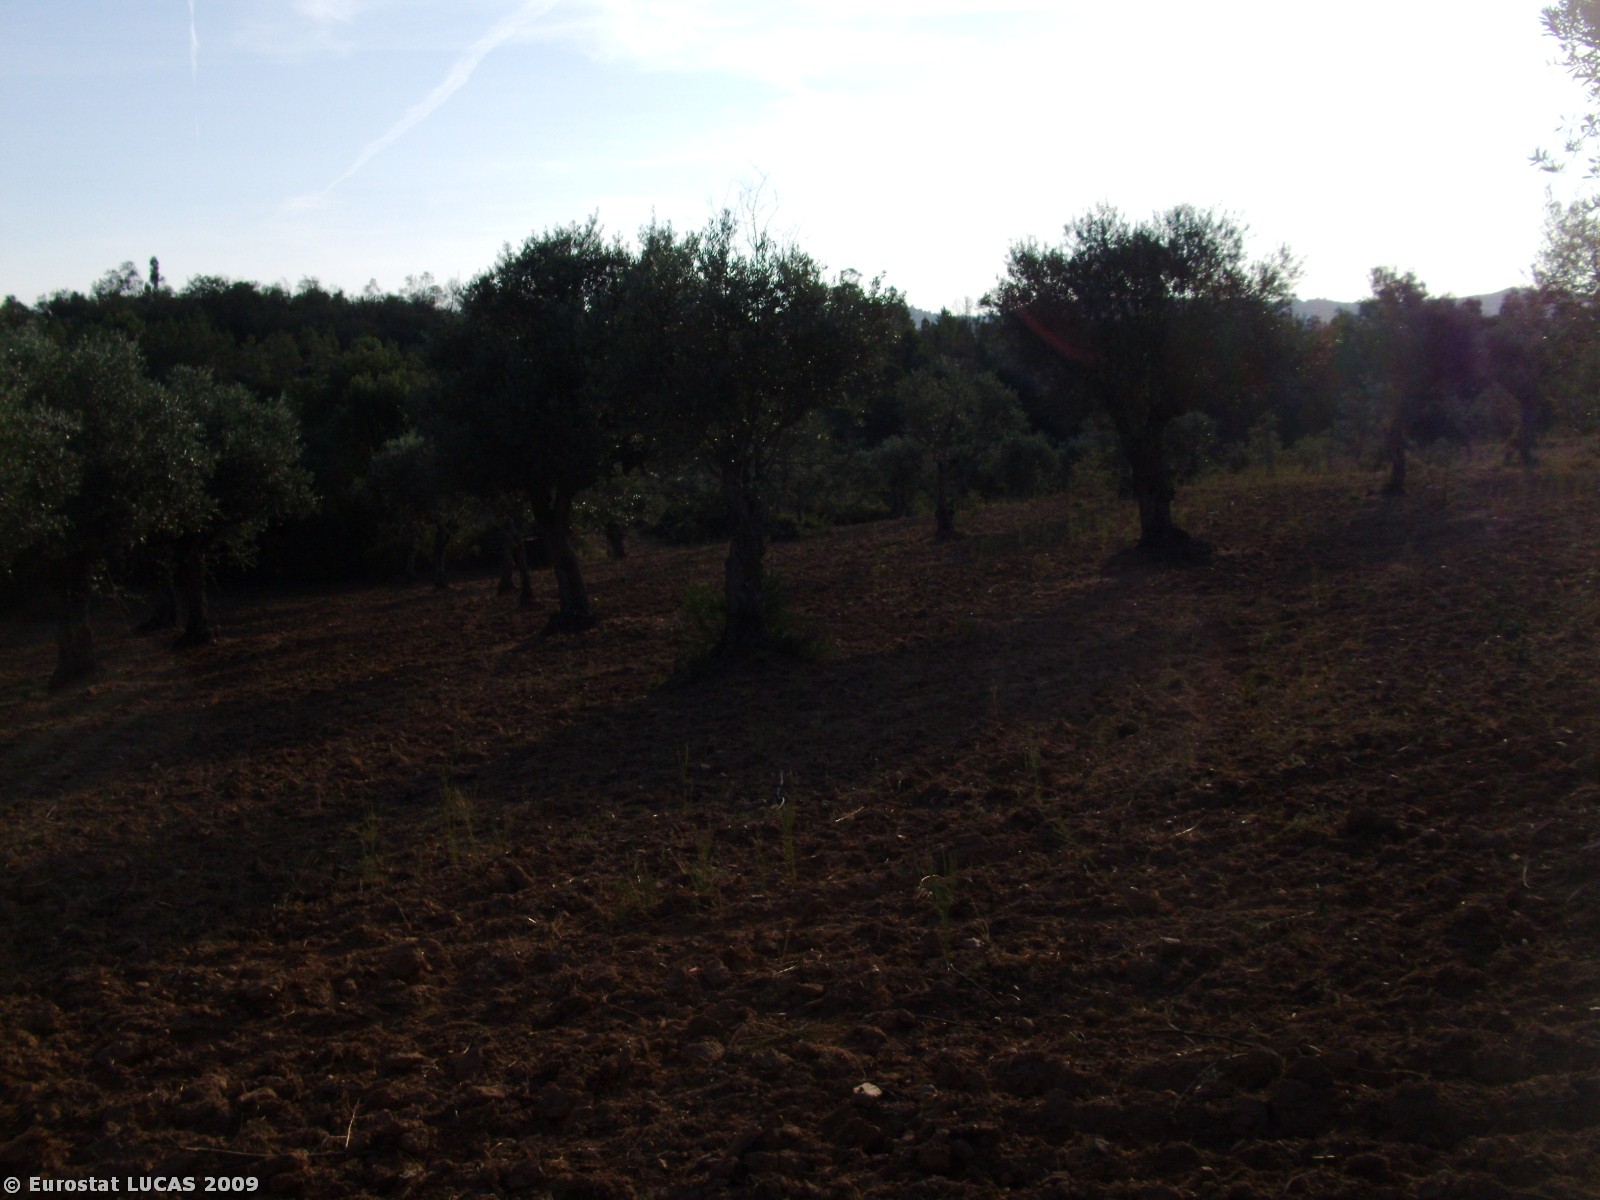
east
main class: Cropland
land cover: Olive groves
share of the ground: 50 - 75 %
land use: Agriculture (excluding fallow land and kitchen gardens)
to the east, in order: Olive groves; Broadleaved woodland; Olive groves; Broadleaved woodland; Dry stone walls; Olive groves; Mixed woodland; Dry stone walls; Tracks
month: June
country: PT
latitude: 40.0768
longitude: -7.2294
